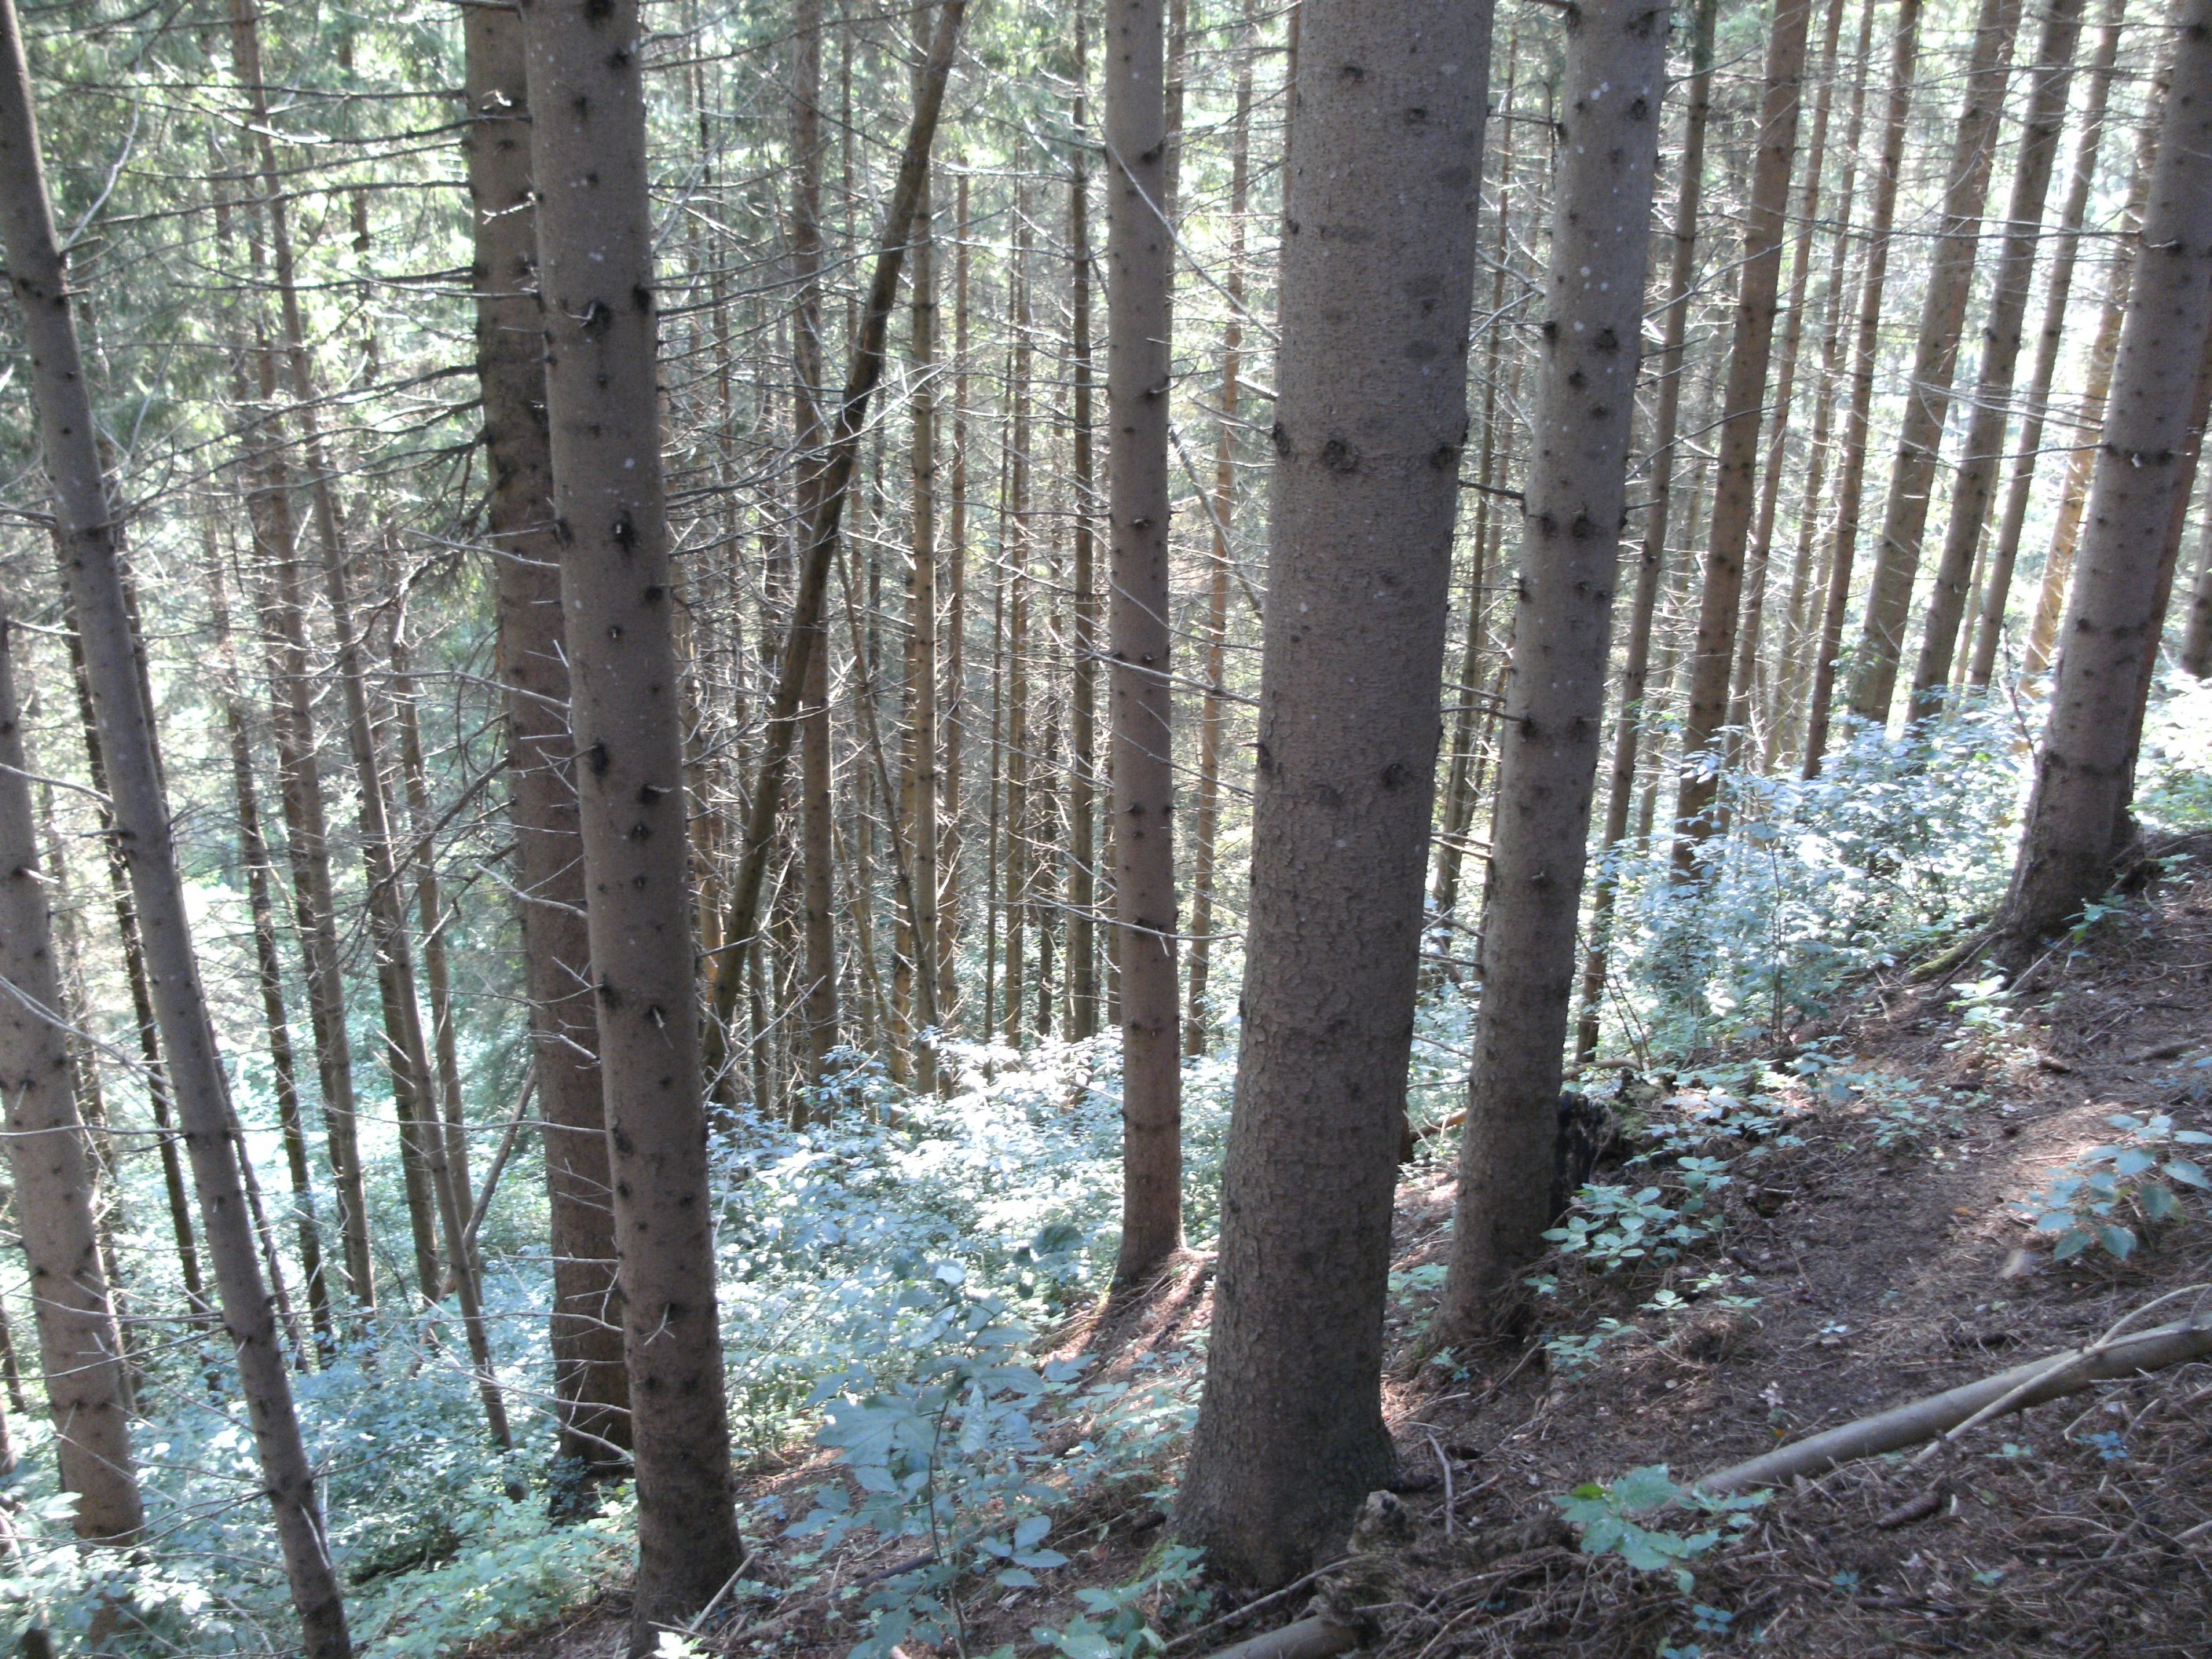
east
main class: Woodland
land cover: Spruce dominated coniferous woodland
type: hemiboreal forest and nemoral coniferous forest and mixed broadleaved-coniferous forest
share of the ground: > 75 %
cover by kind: coniferous forest trees 85 %, shrubs 10 %, unconsolidated bare surface 5 %
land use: Forestry
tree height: > 5 m
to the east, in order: Spruce dominated coniferous woodland; Tracks; Spruce dominated mixed woodland; Rivers and streams; Spruce dominated mixed woodland; Tracks; Spruce dominated coniferous woodland; Tracks; Spruce dominated coniferous woodland; Tracks
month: July
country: AT
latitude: 46.6708
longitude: 14.9260
